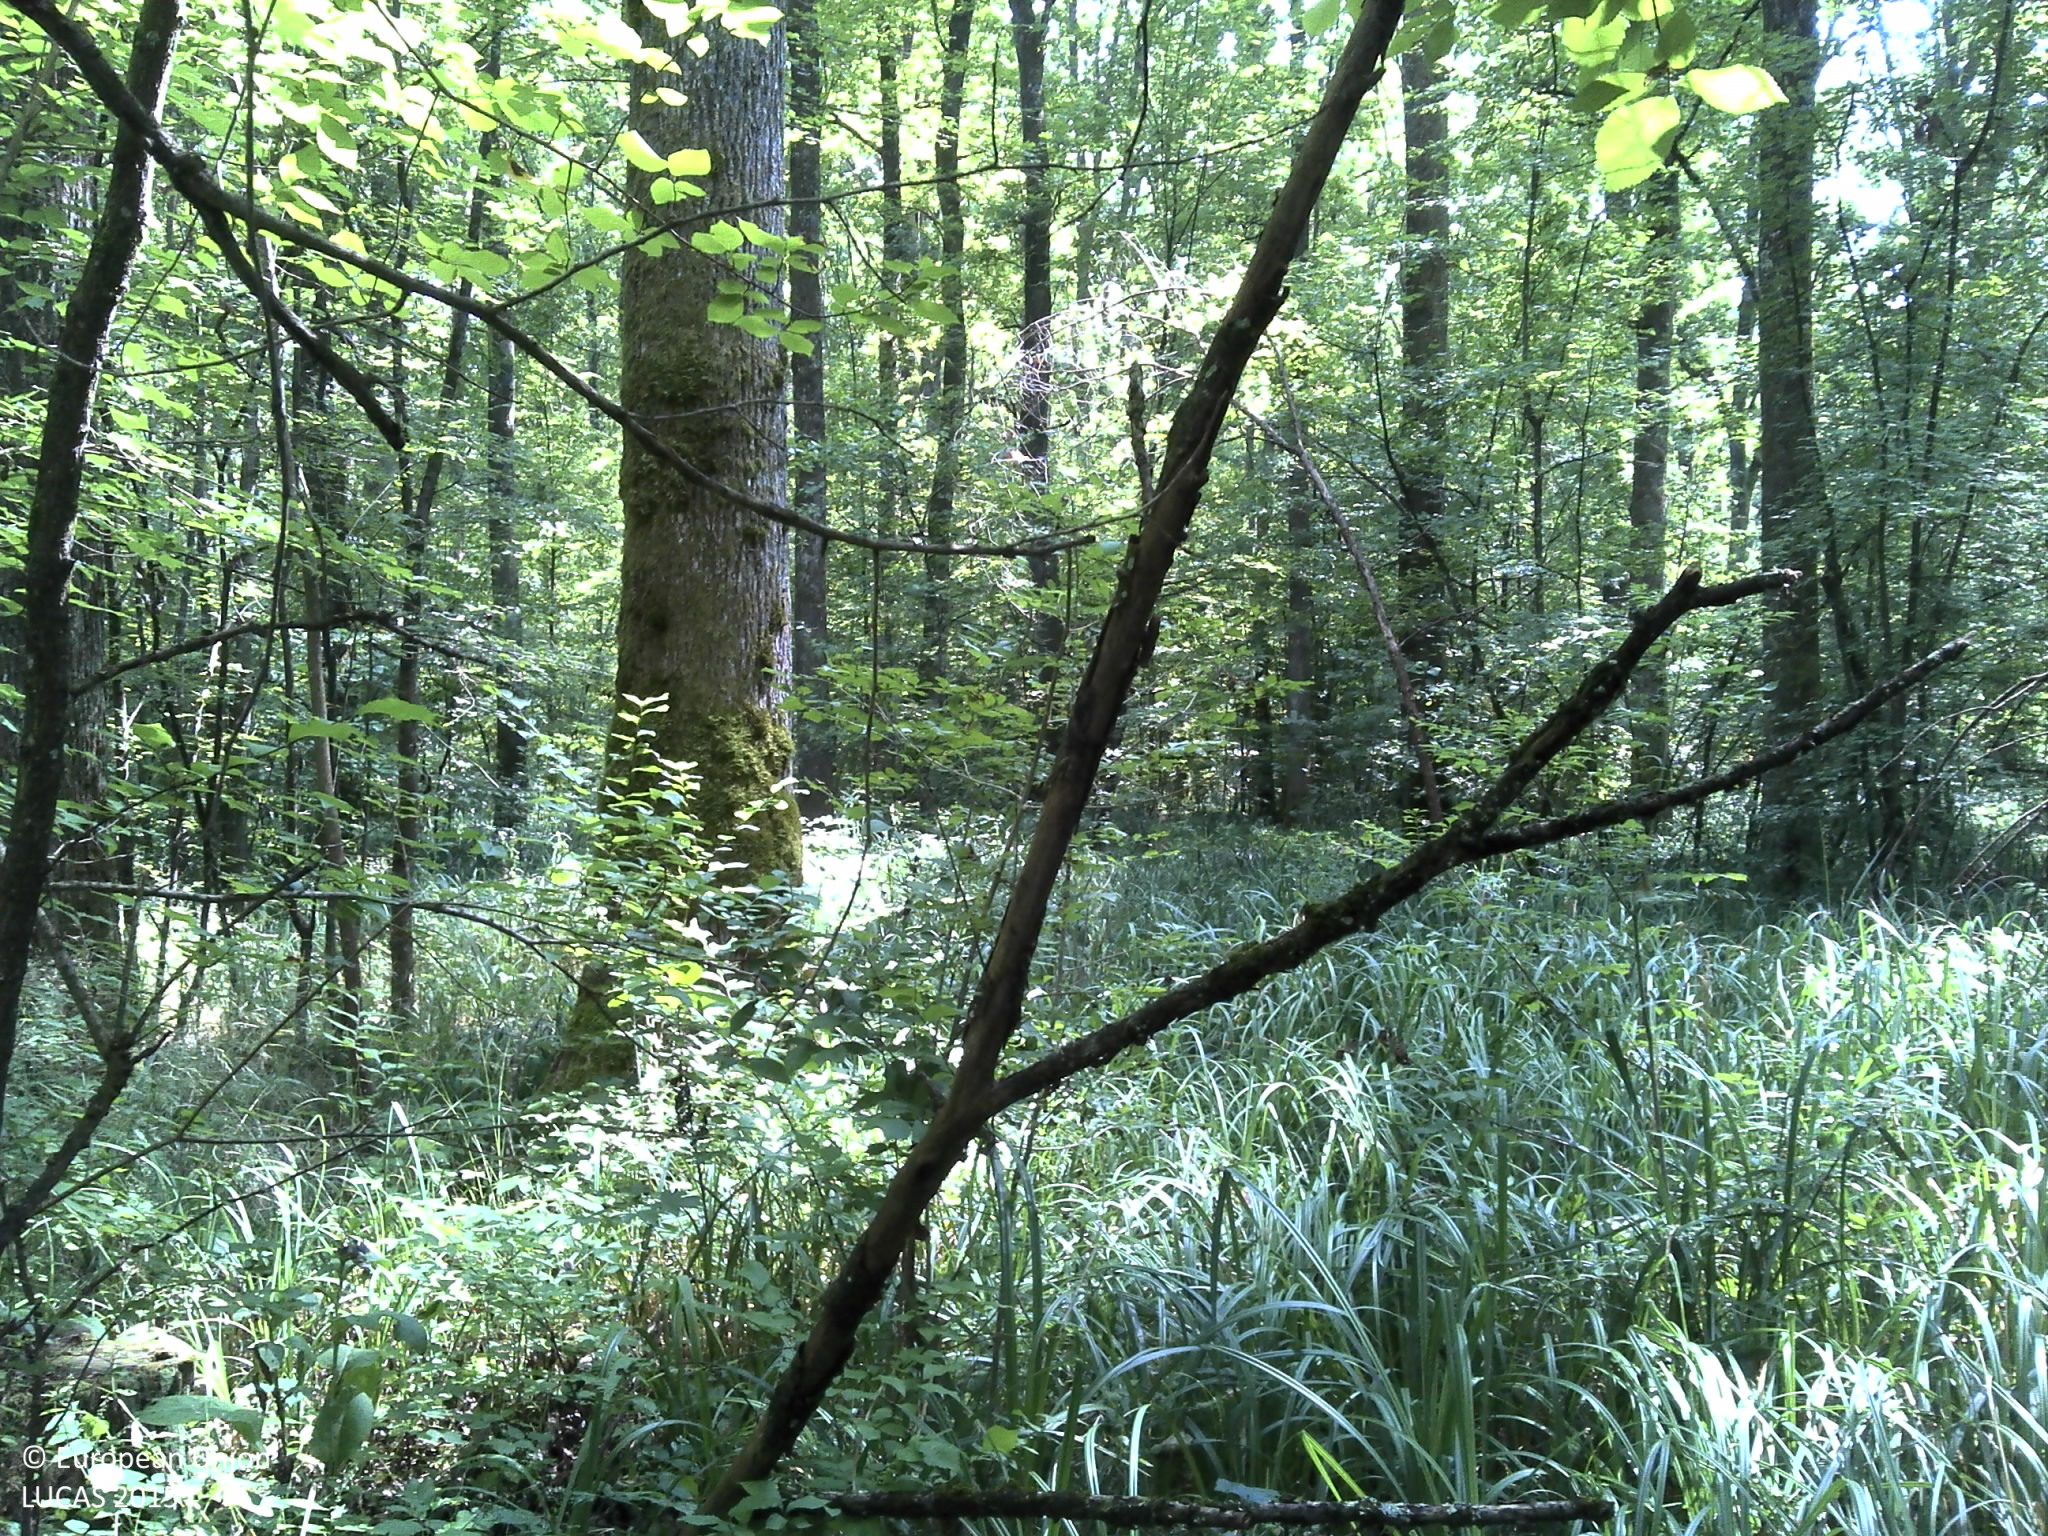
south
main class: Woodland
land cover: Broadleaved woodland
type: acidophilous oak and oak-birch forest
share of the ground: > 75 %
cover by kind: broadleaved forest trees 80 %, lichens and mosses 20 %
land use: Forestry
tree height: > 5 m
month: August
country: HR
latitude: 45.5021
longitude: 16.5125
